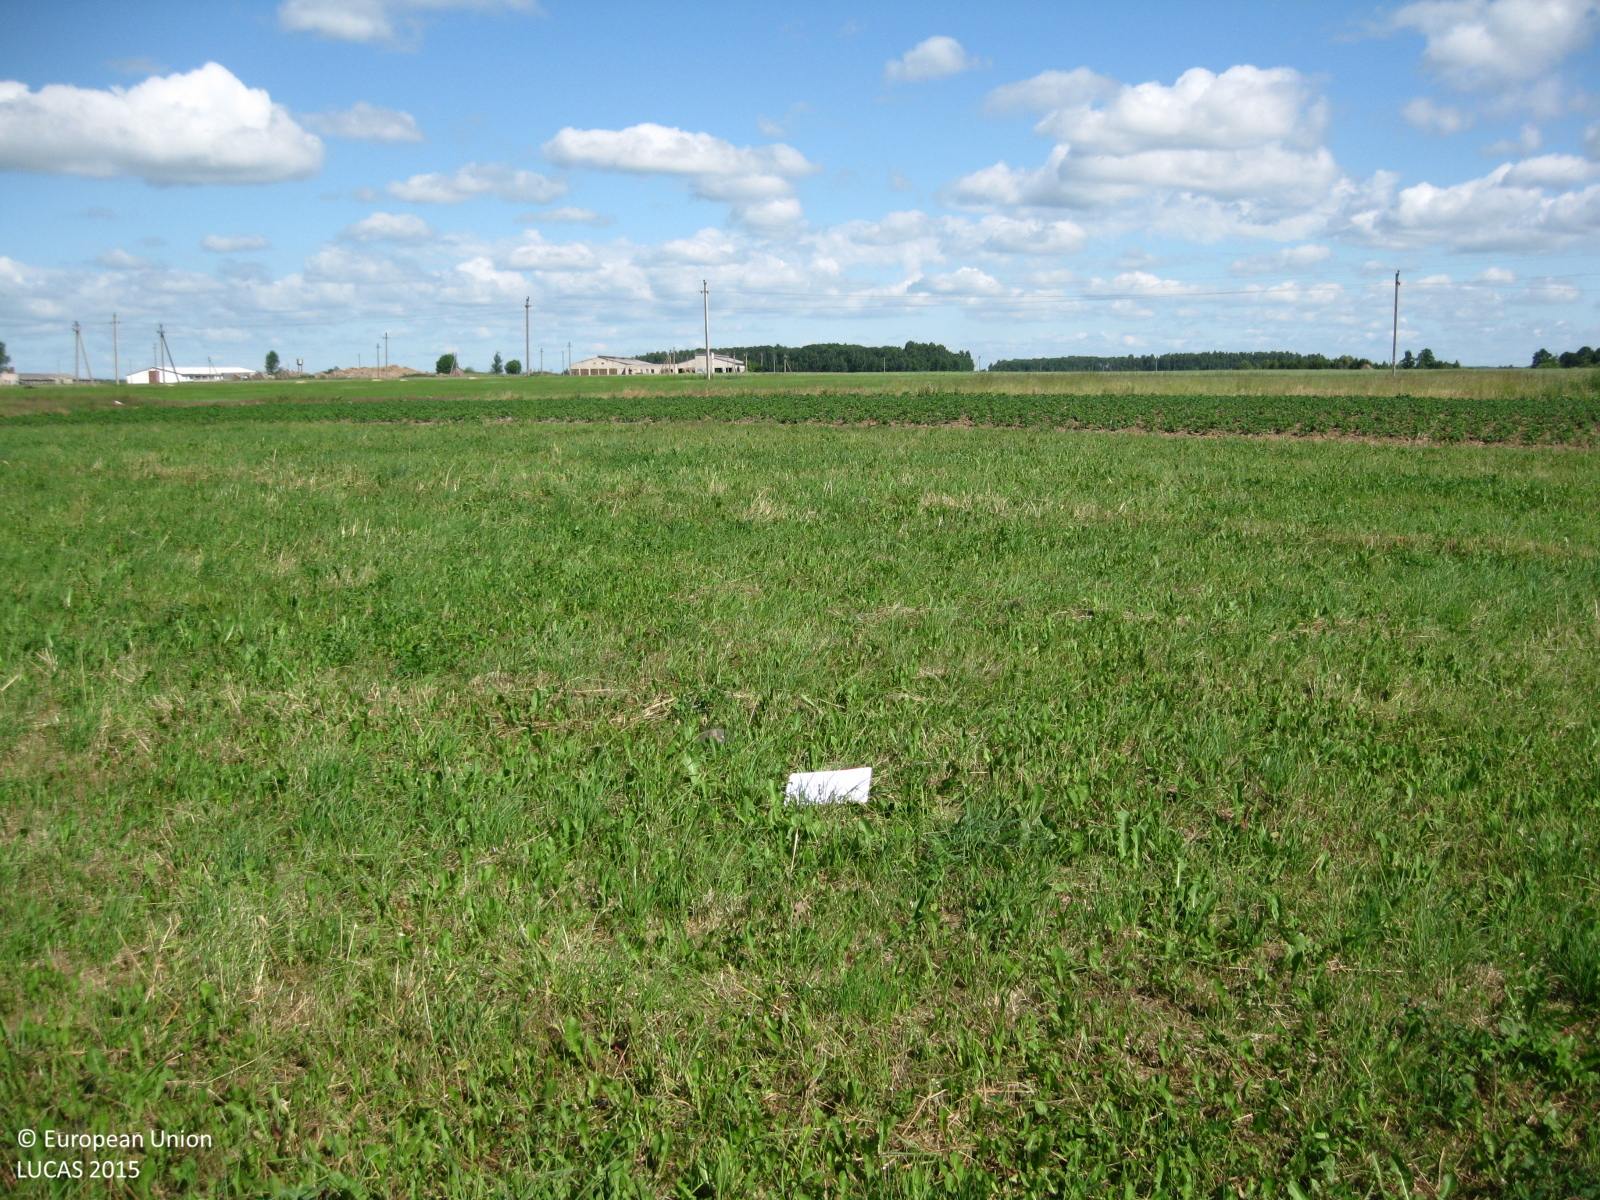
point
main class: Grassland
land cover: Grassland without tree/shrub cover
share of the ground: > 75 %
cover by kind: herbaceous plants 90 %, unconsolidated bare surface 10 %
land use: Agriculture (excluding fallow land and kitchen gardens)
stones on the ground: < 10 %
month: June
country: LT
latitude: 55.4320
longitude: 24.1740
